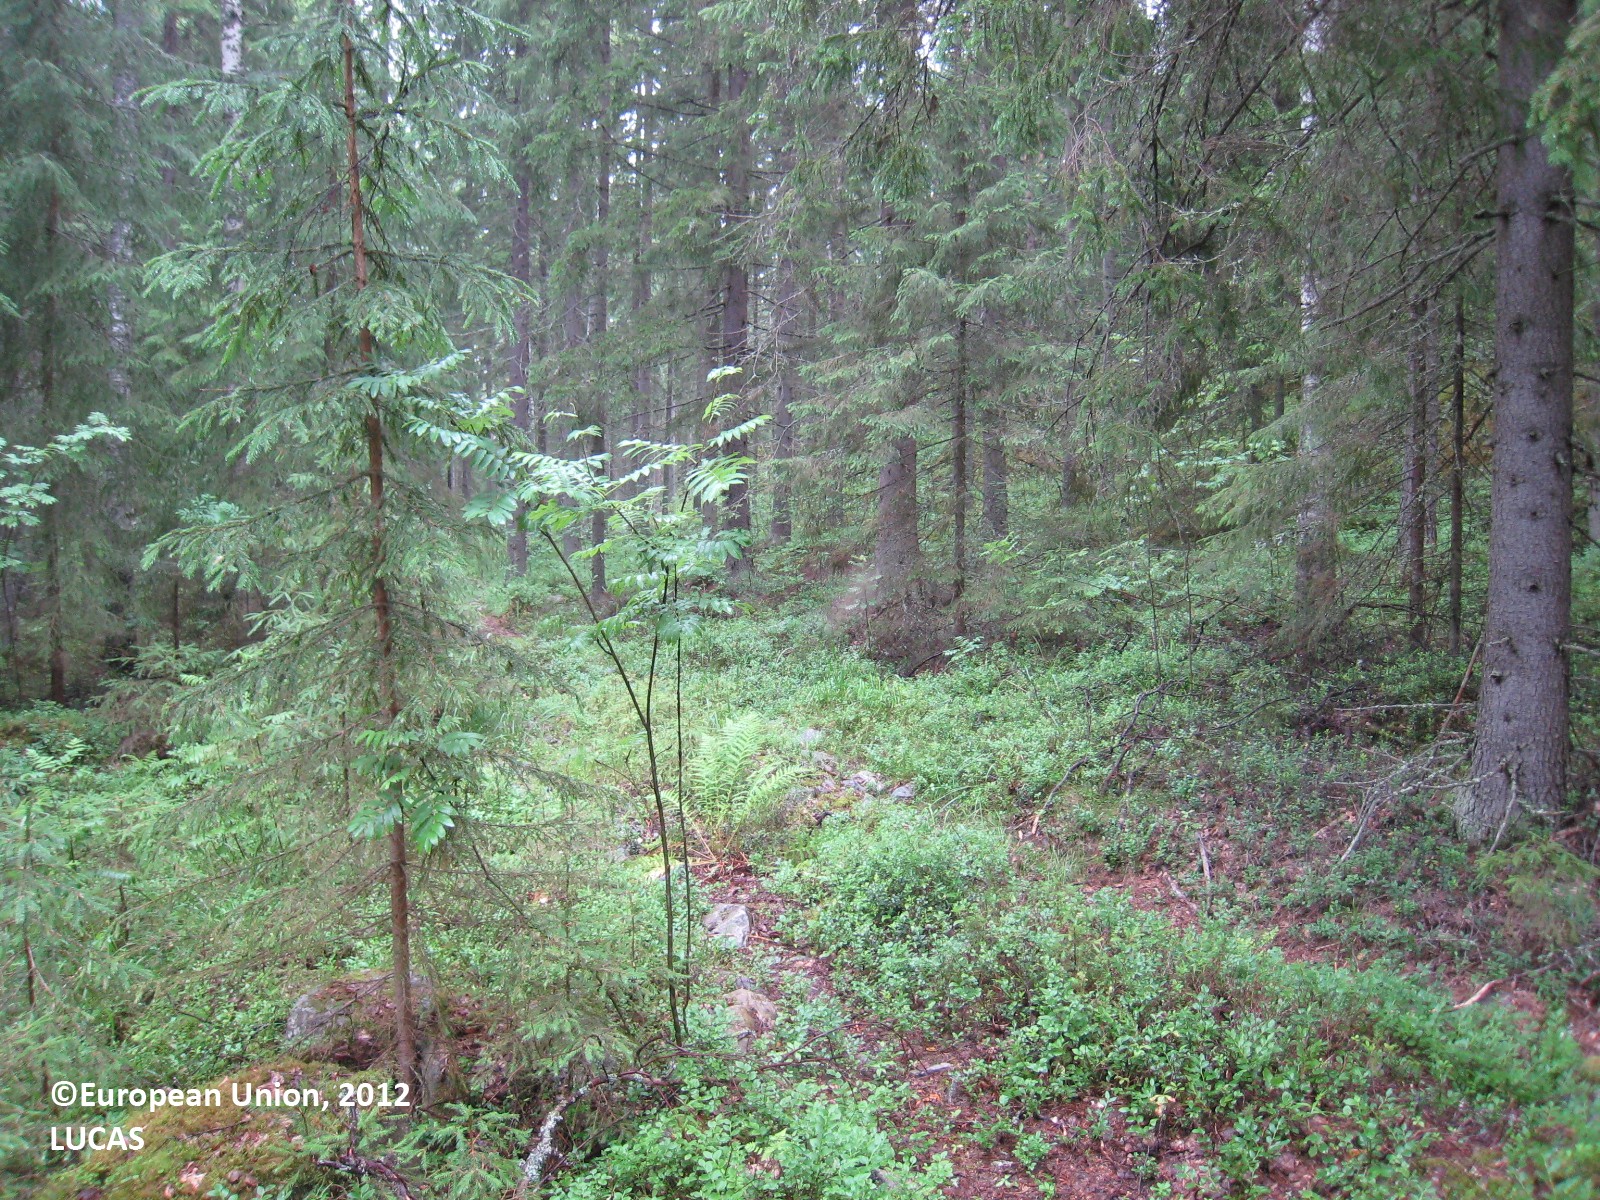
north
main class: Woodland
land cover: Spruce dominated mixed woodland
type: boreal forest
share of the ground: 50 - 75 %
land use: Forestry
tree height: > 5 m
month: July
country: FI
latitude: 61.7807
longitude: 27.0131
